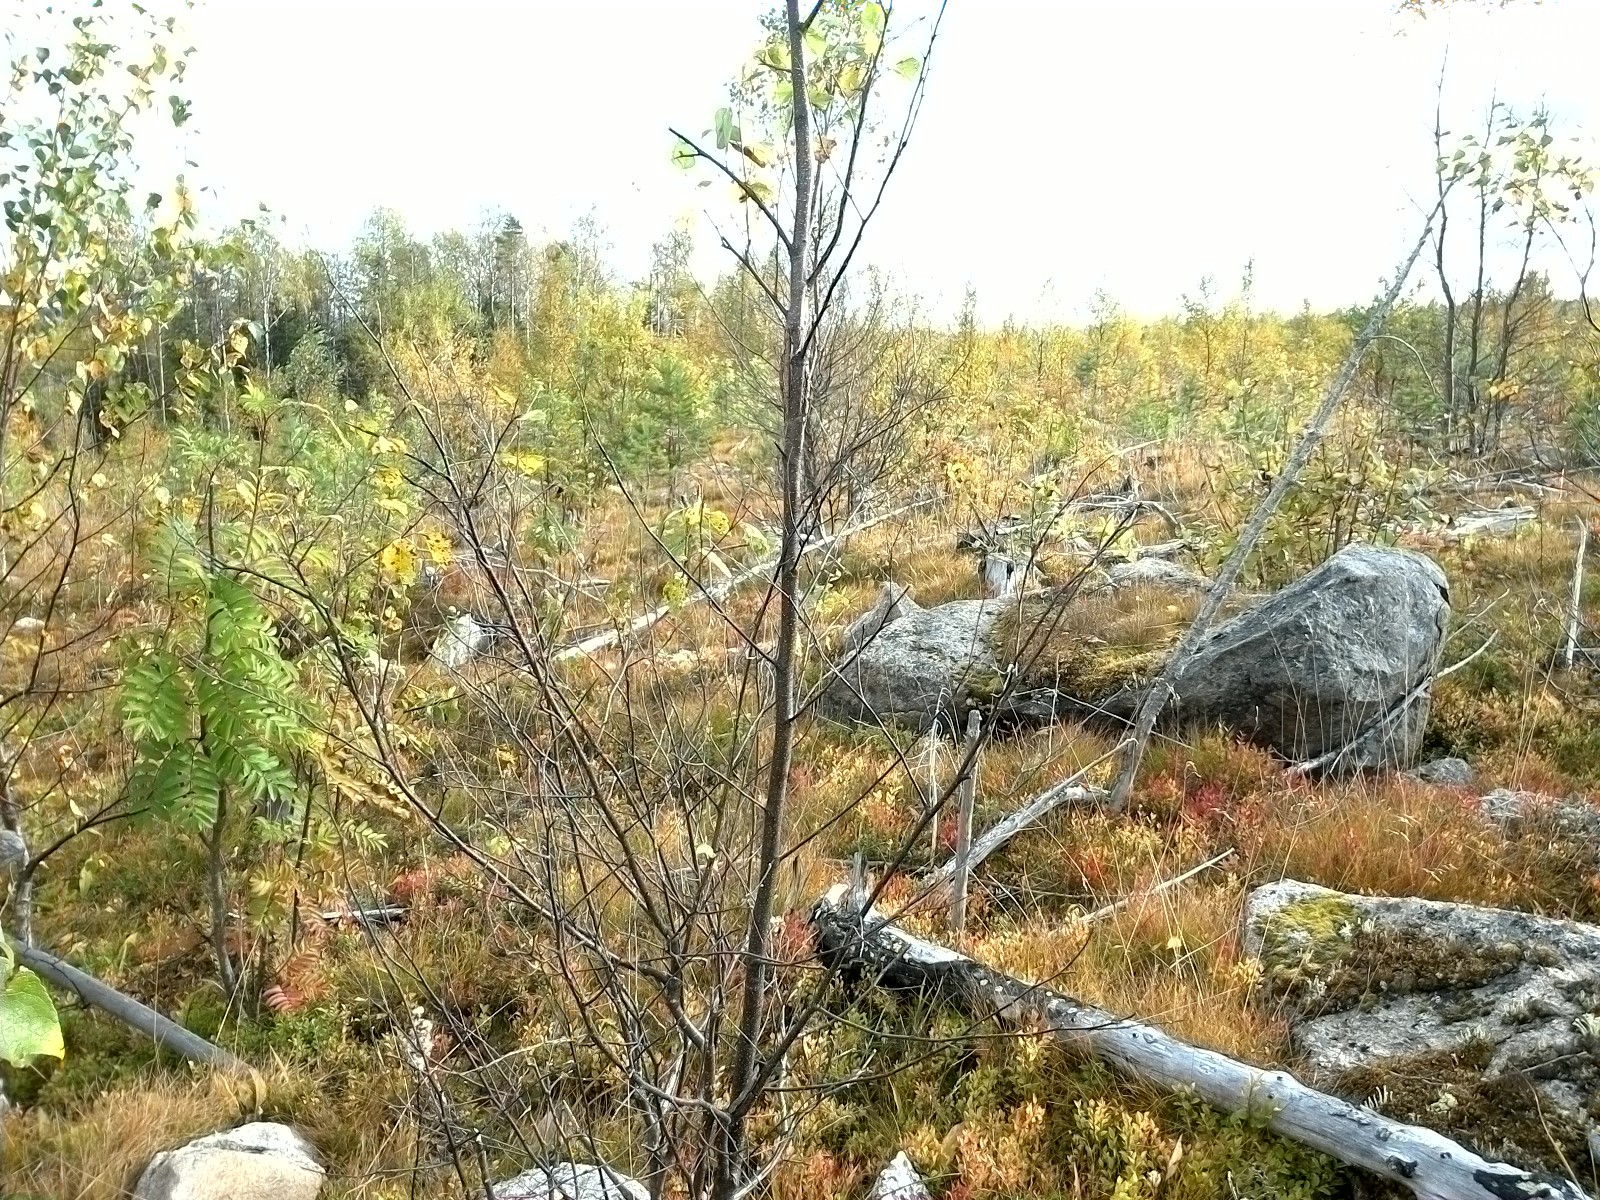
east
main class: Woodland
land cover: Broadleaved woodland
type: boreal forest
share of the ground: 25 - 50 %
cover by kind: herbaceous plants 55 %, broadleaved forest trees 25 %, shrubs 20 %
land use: Forestry
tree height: < 5 m
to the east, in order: Broadleaved woodland; Spruce dominated mixed woodland; Shrubland with sparse tree cover; Broadleaved woodland; Spruce dominated mixed woodland; Broadleaved woodland
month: September
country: SE
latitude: 62.2480
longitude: 16.2368
